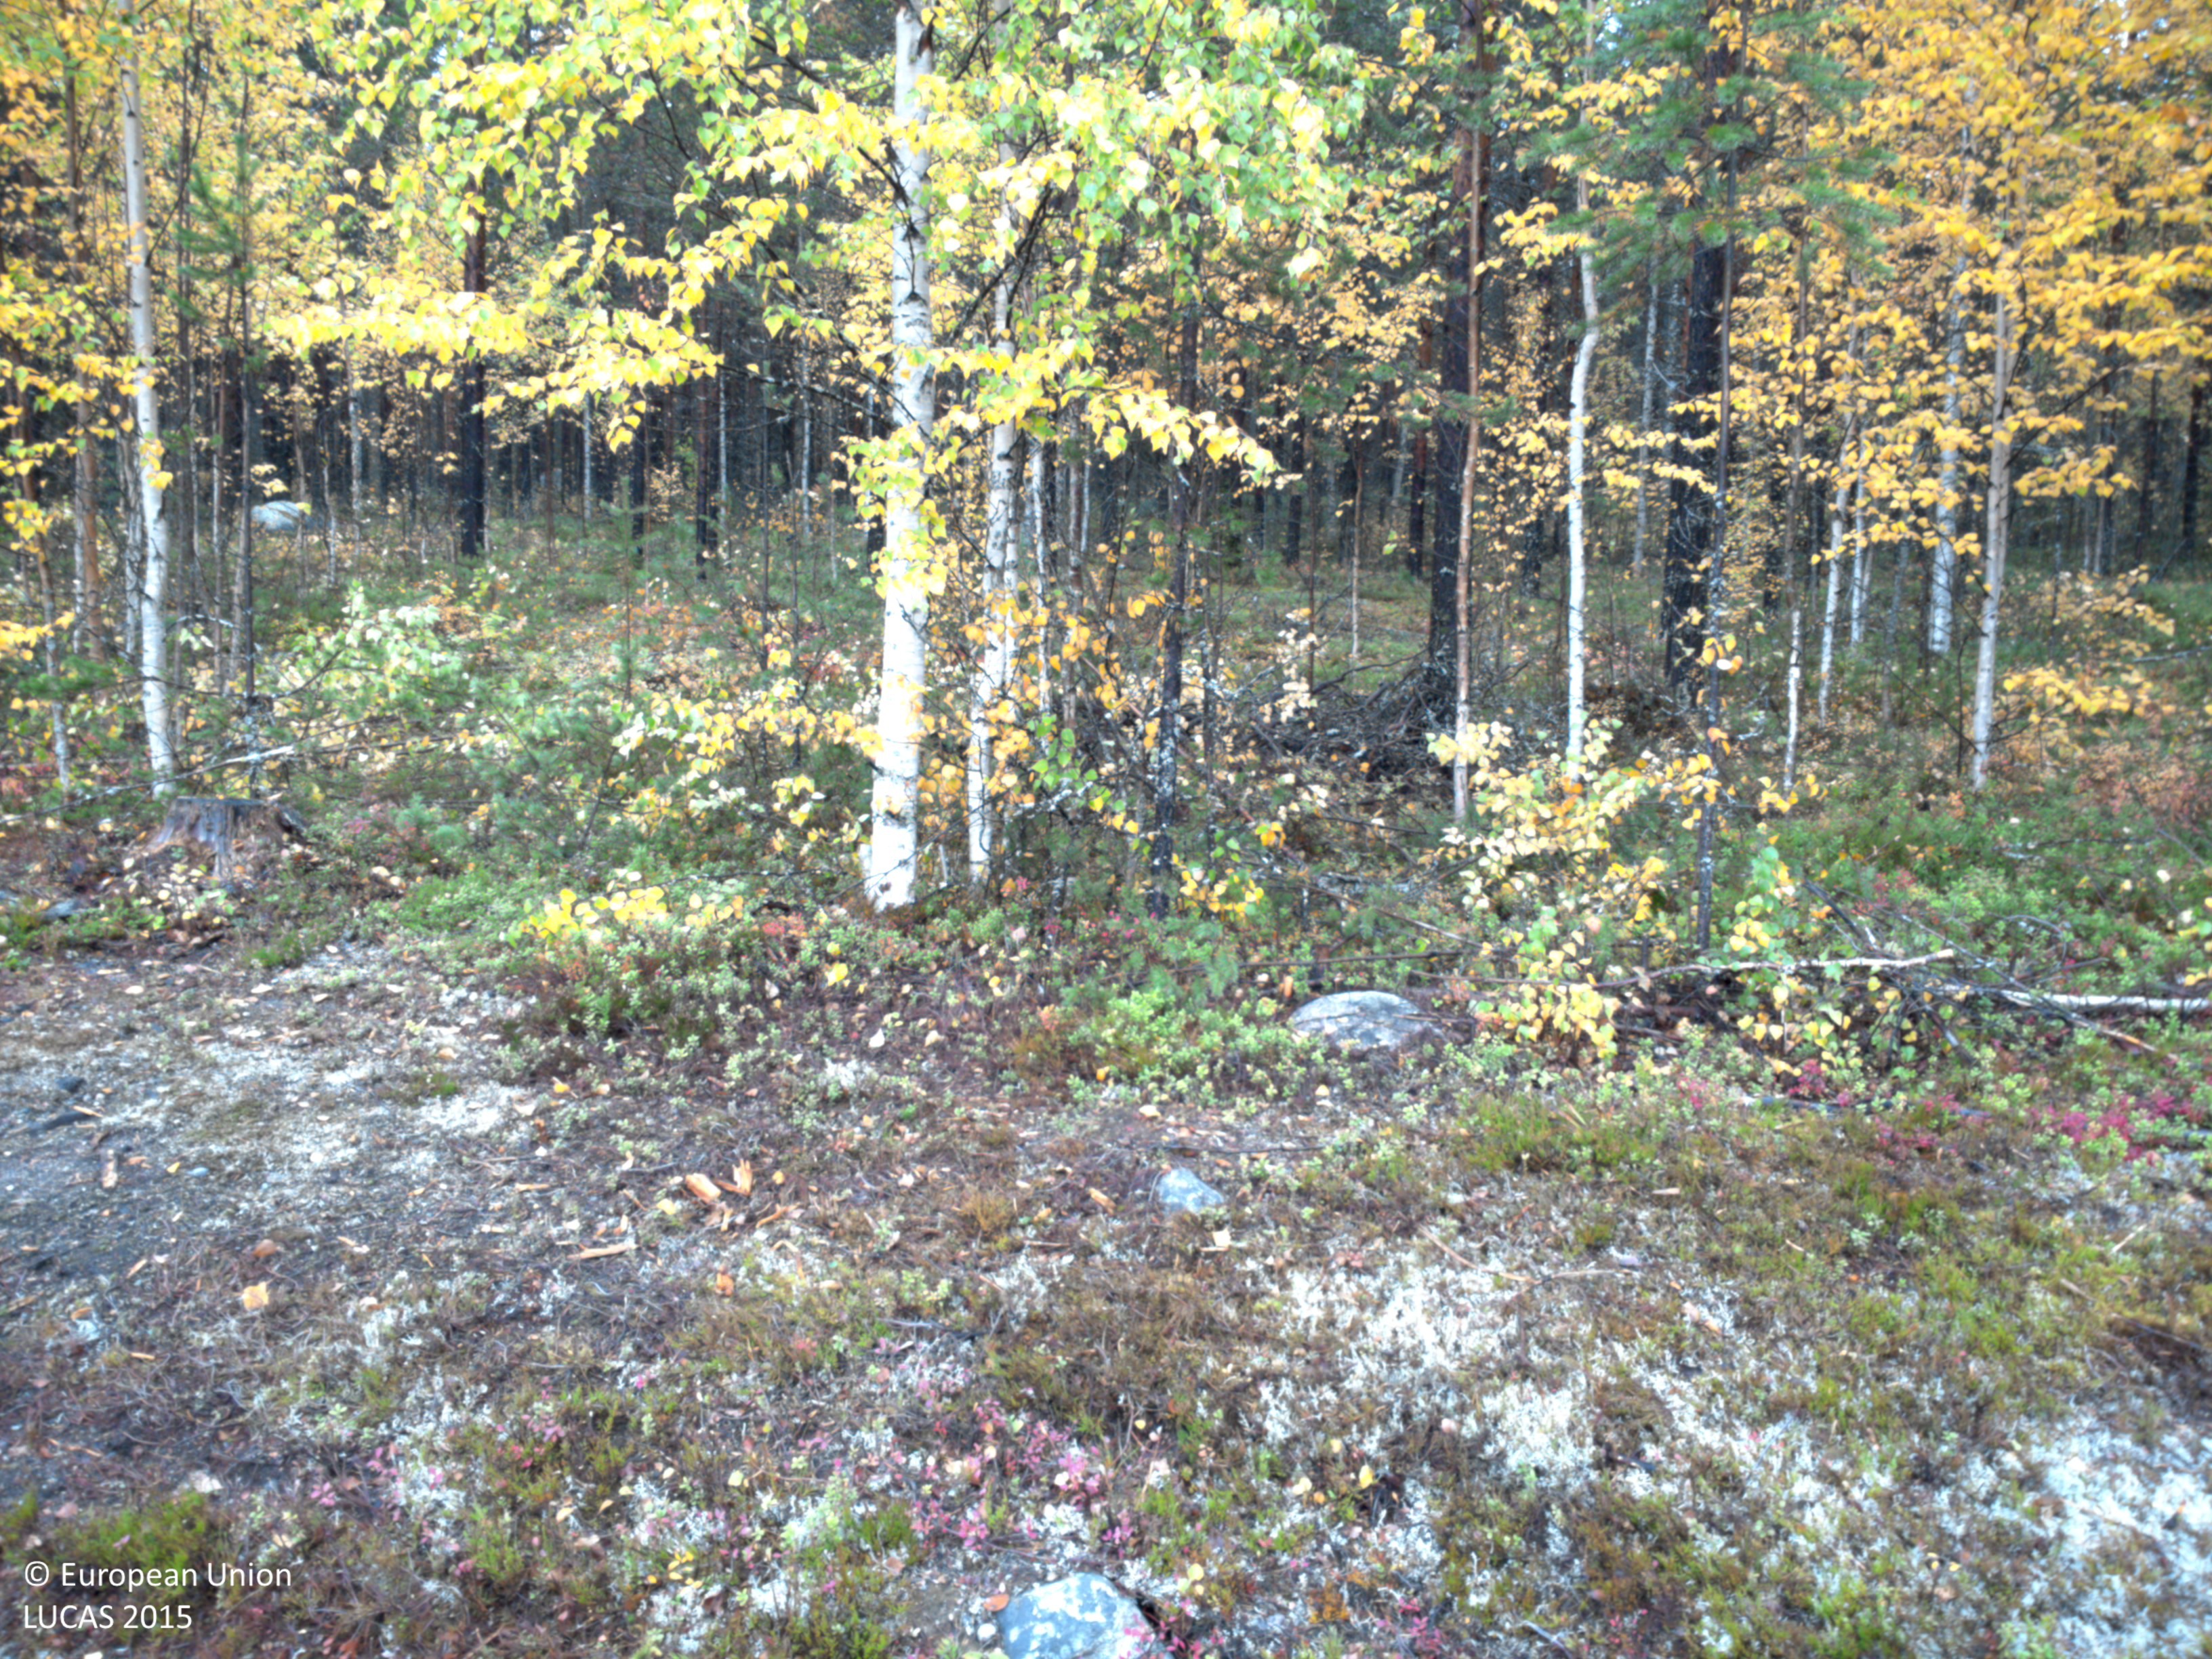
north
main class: Woodland
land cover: Pine dominated mixed woodland
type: boreal forest
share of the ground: > 75 %
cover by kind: coniferous forest trees 55 %, broadleaved forest trees 25 %, shrubs 10 %, herbaceous plants 5 %, lichens and mosses 5 %
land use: Forestry
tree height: > 5 m
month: September
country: SE
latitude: 64.7168
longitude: 19.1387
